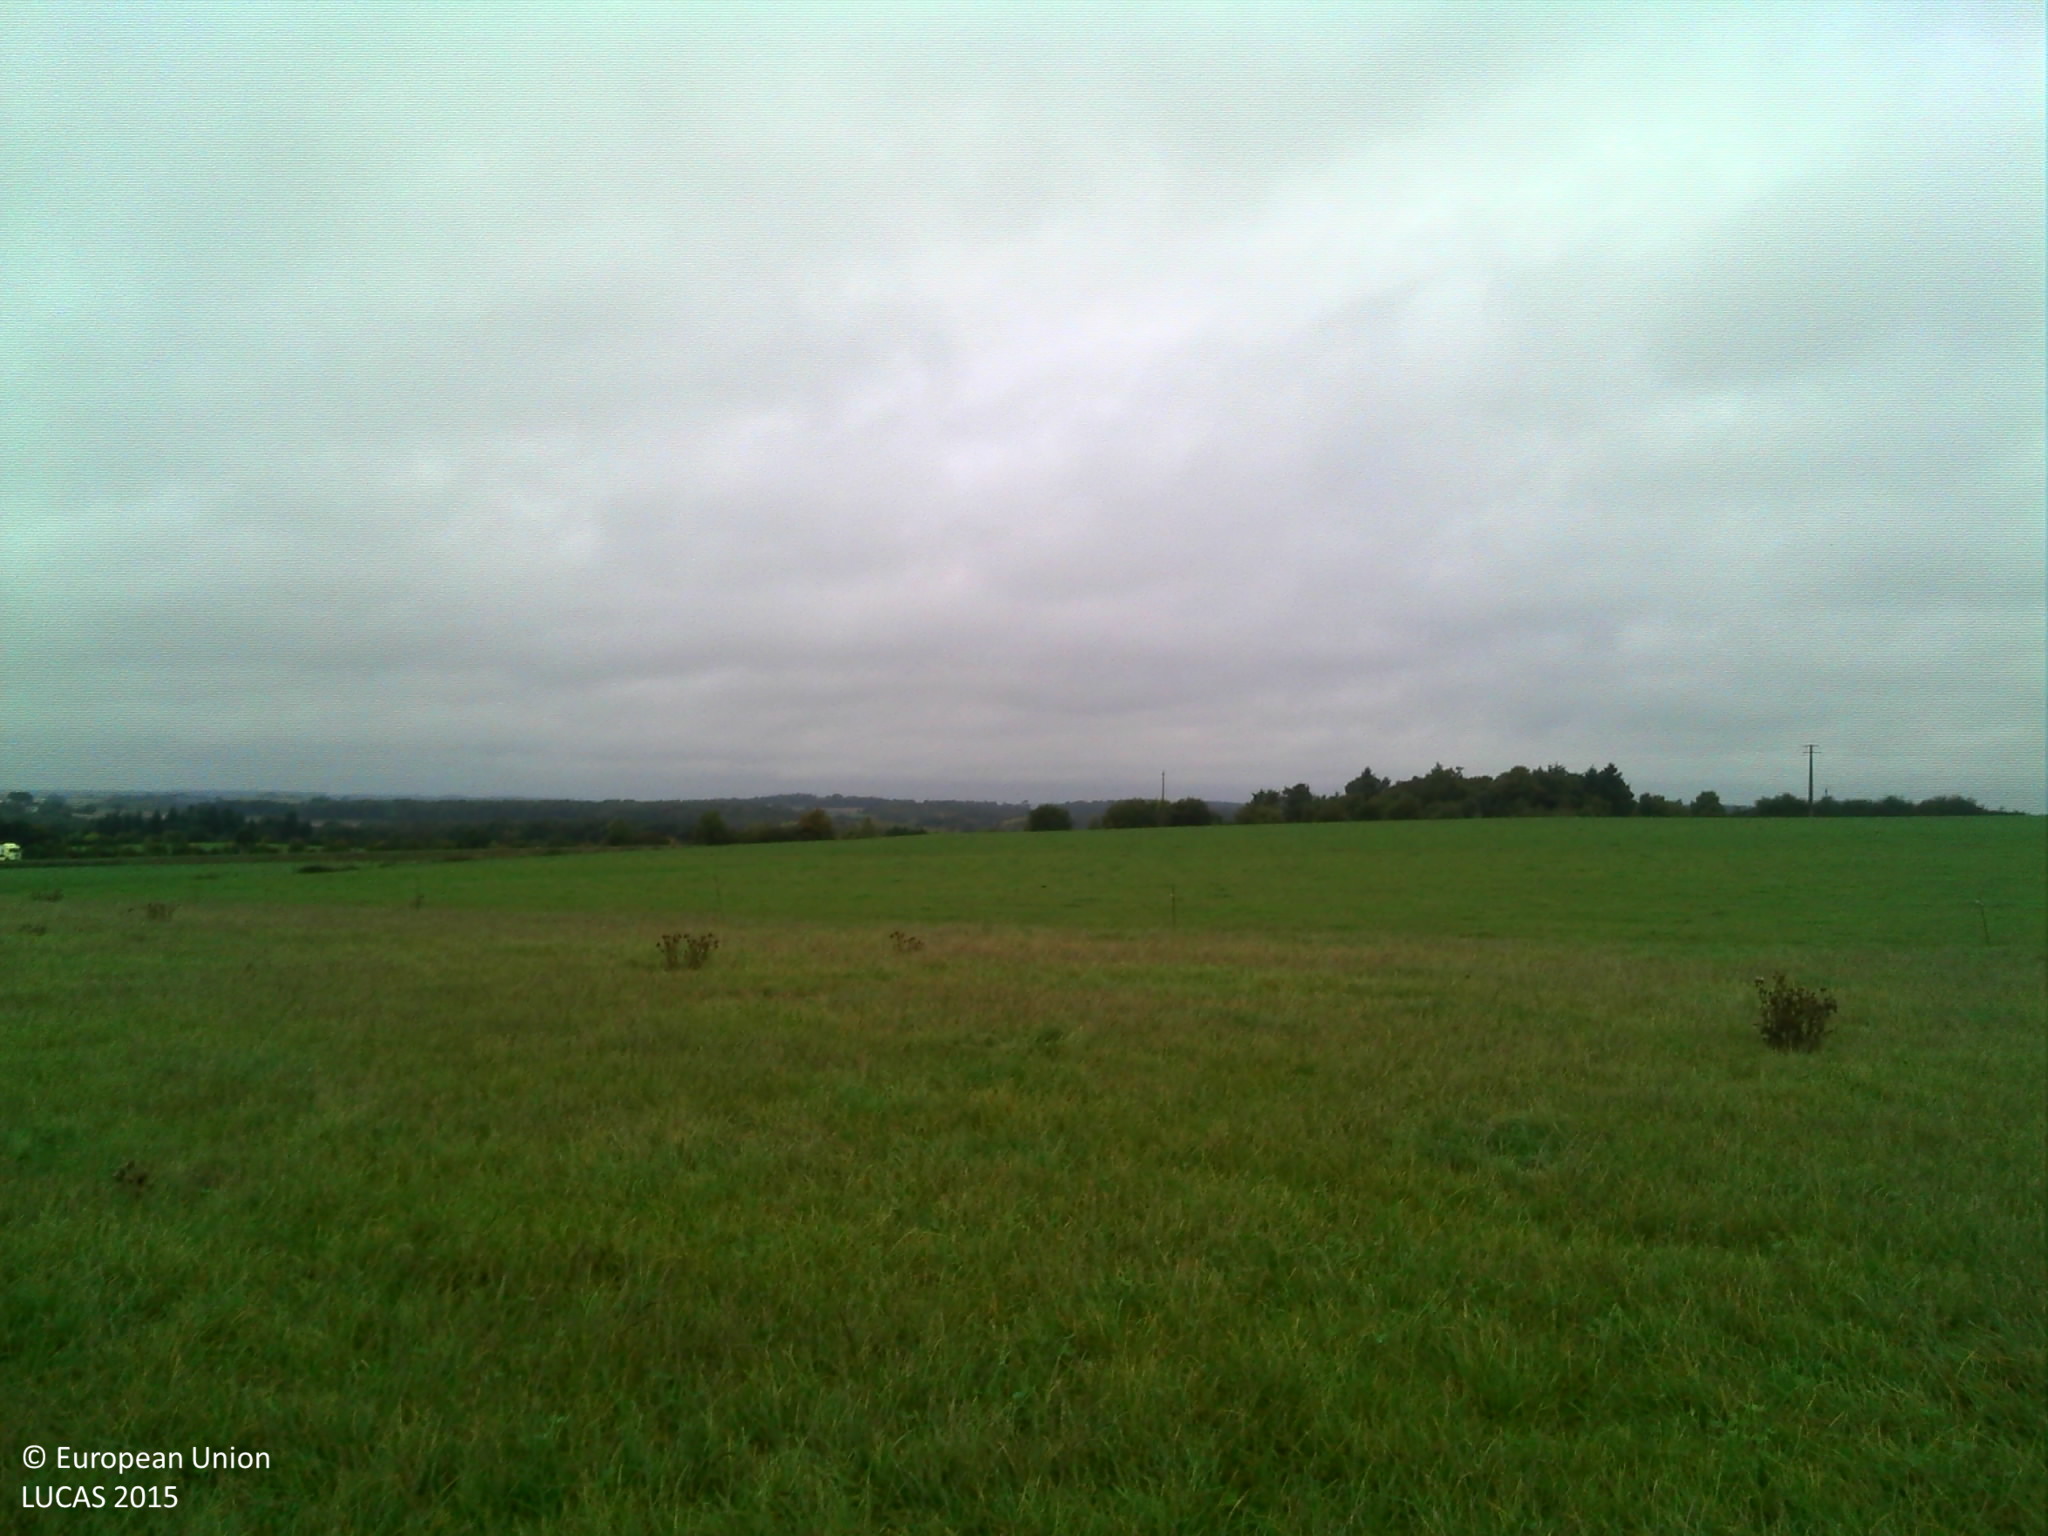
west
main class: Cropland
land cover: Temporary grasslands
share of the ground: > 75 %
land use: Agriculture (excluding fallow land and kitchen gardens)
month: October
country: FR
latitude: 47.9788
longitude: -2.3694
